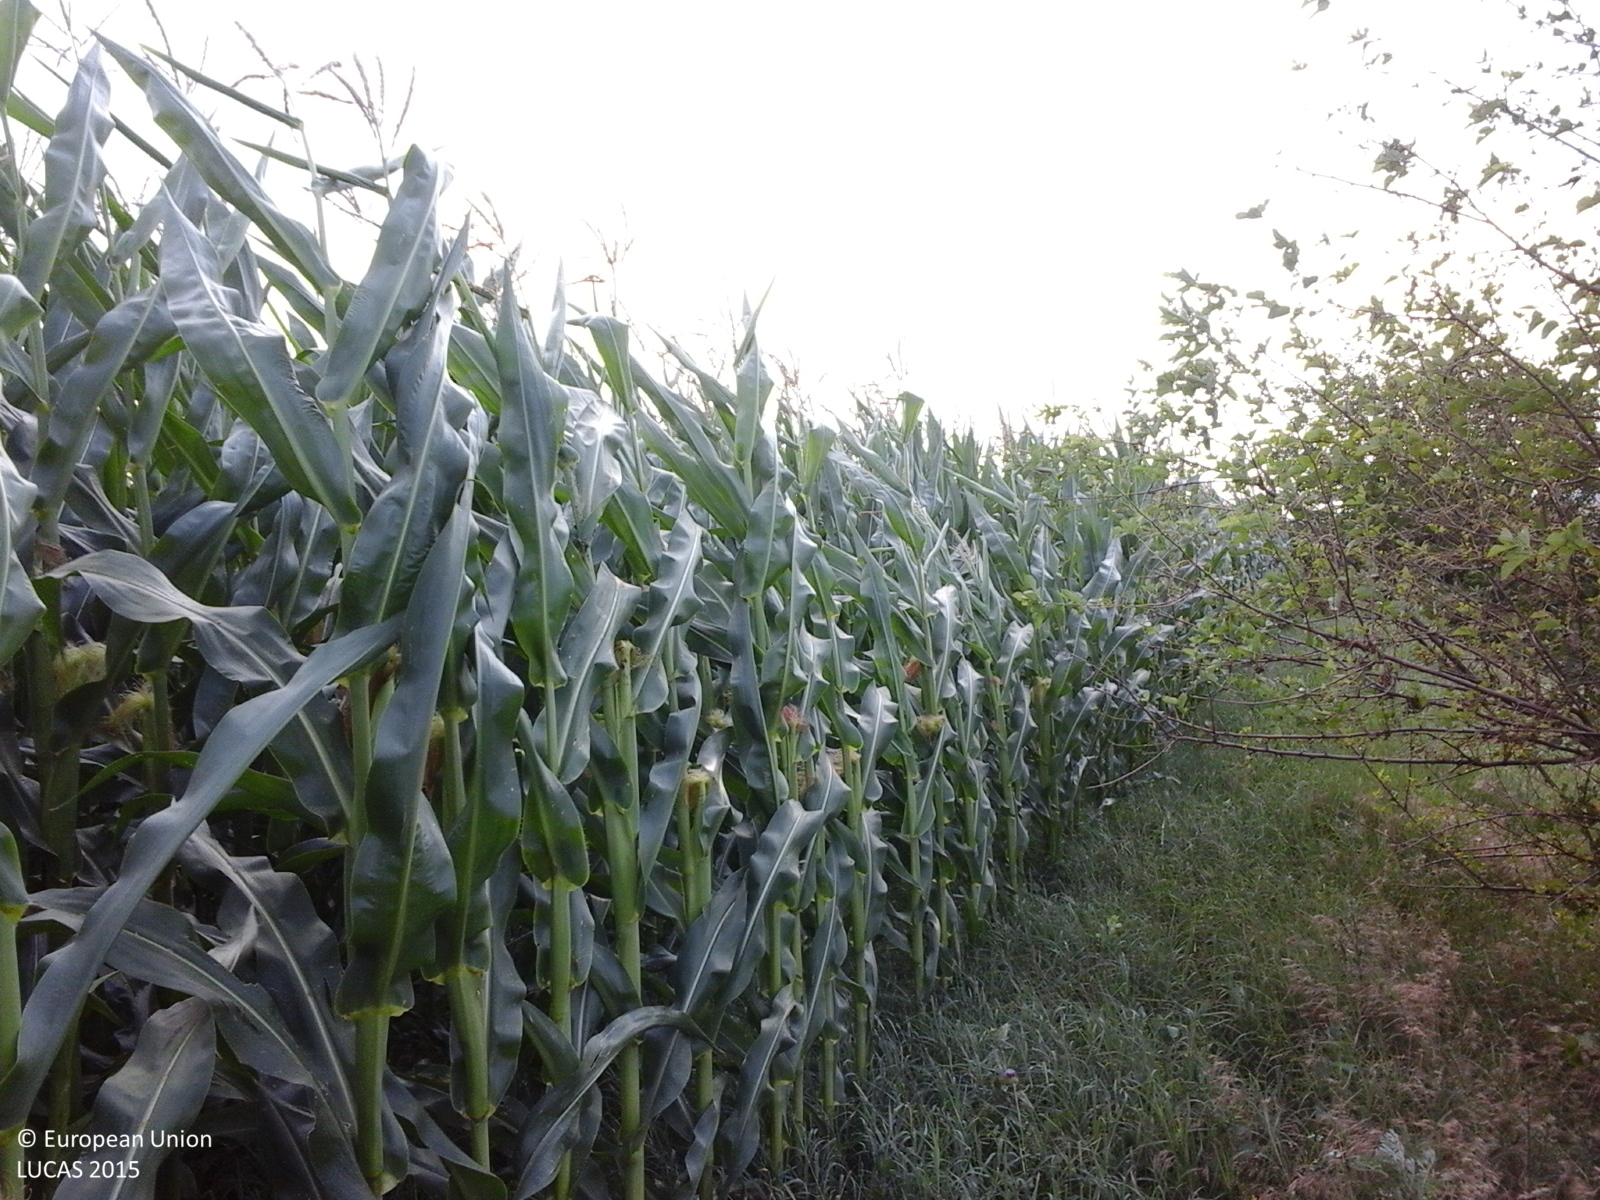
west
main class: Cropland
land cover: Maize
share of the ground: > 75 %
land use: Agriculture (excluding fallow land and kitchen gardens)
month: July
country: RO
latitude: 43.7270
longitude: 25.2613
